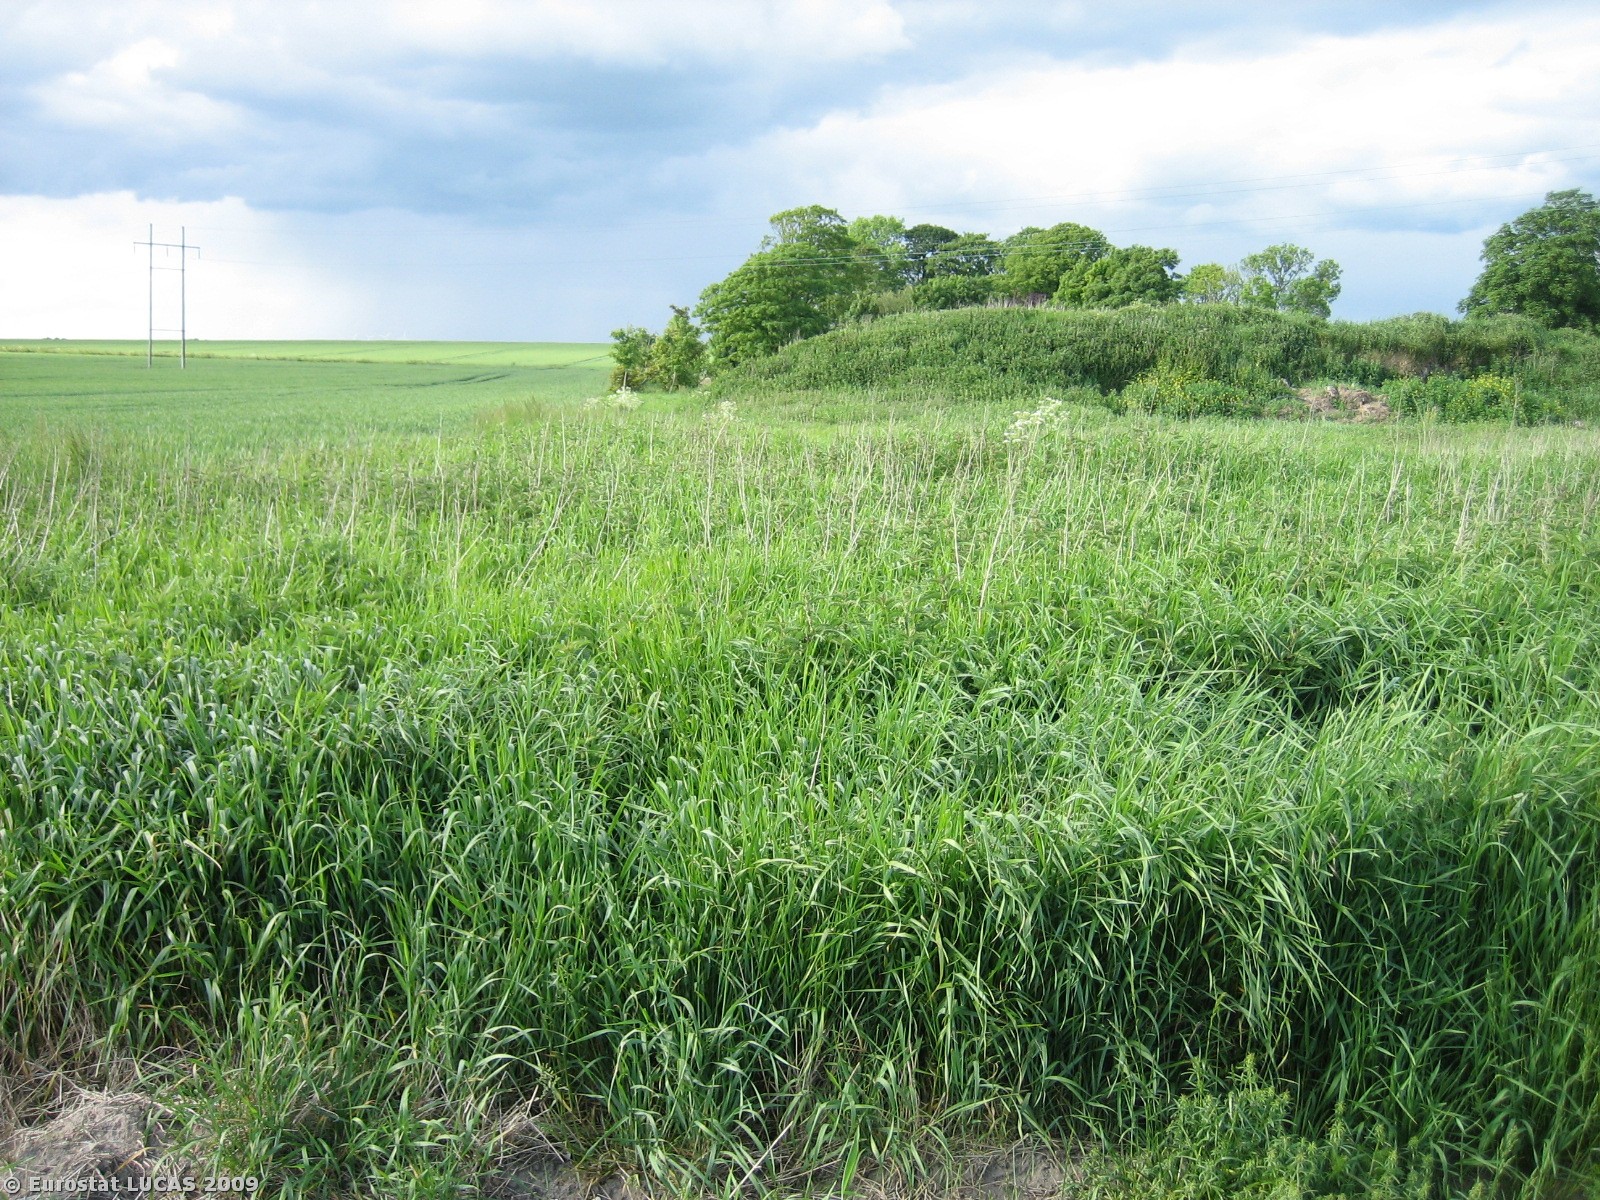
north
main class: Cropland
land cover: Common wheat
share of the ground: > 75 %
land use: Agriculture (excluding fallow land and kitchen gardens)
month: June
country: DK
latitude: 56.2235
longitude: 9.7906
